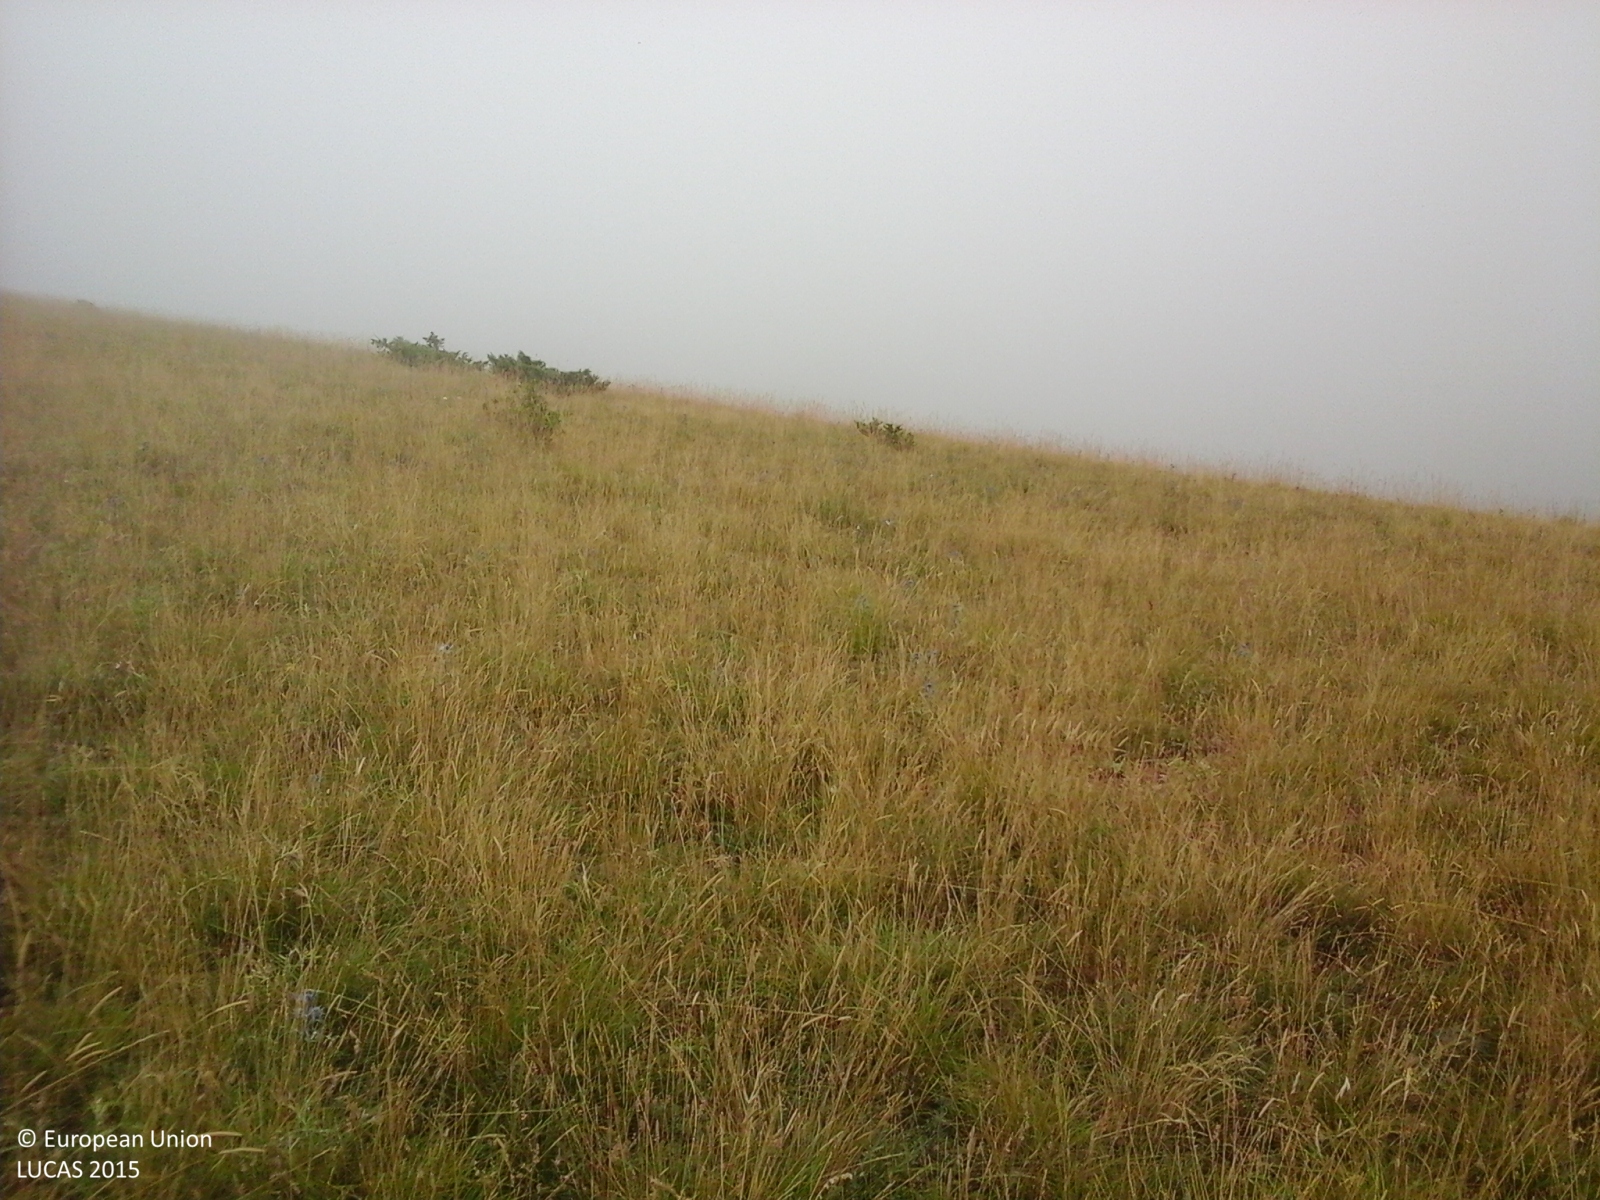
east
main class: Grassland
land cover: Grassland without tree/shrub cover
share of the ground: > 75 %
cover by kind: herbaceous plants 100 %
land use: Agriculture (excluding fallow land and kitchen gardens)
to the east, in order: Grassland without tree/shrub cover; Shrubland without tree cover; Broadleaved woodland
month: August
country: IT
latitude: 43.0373
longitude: 13.1946
